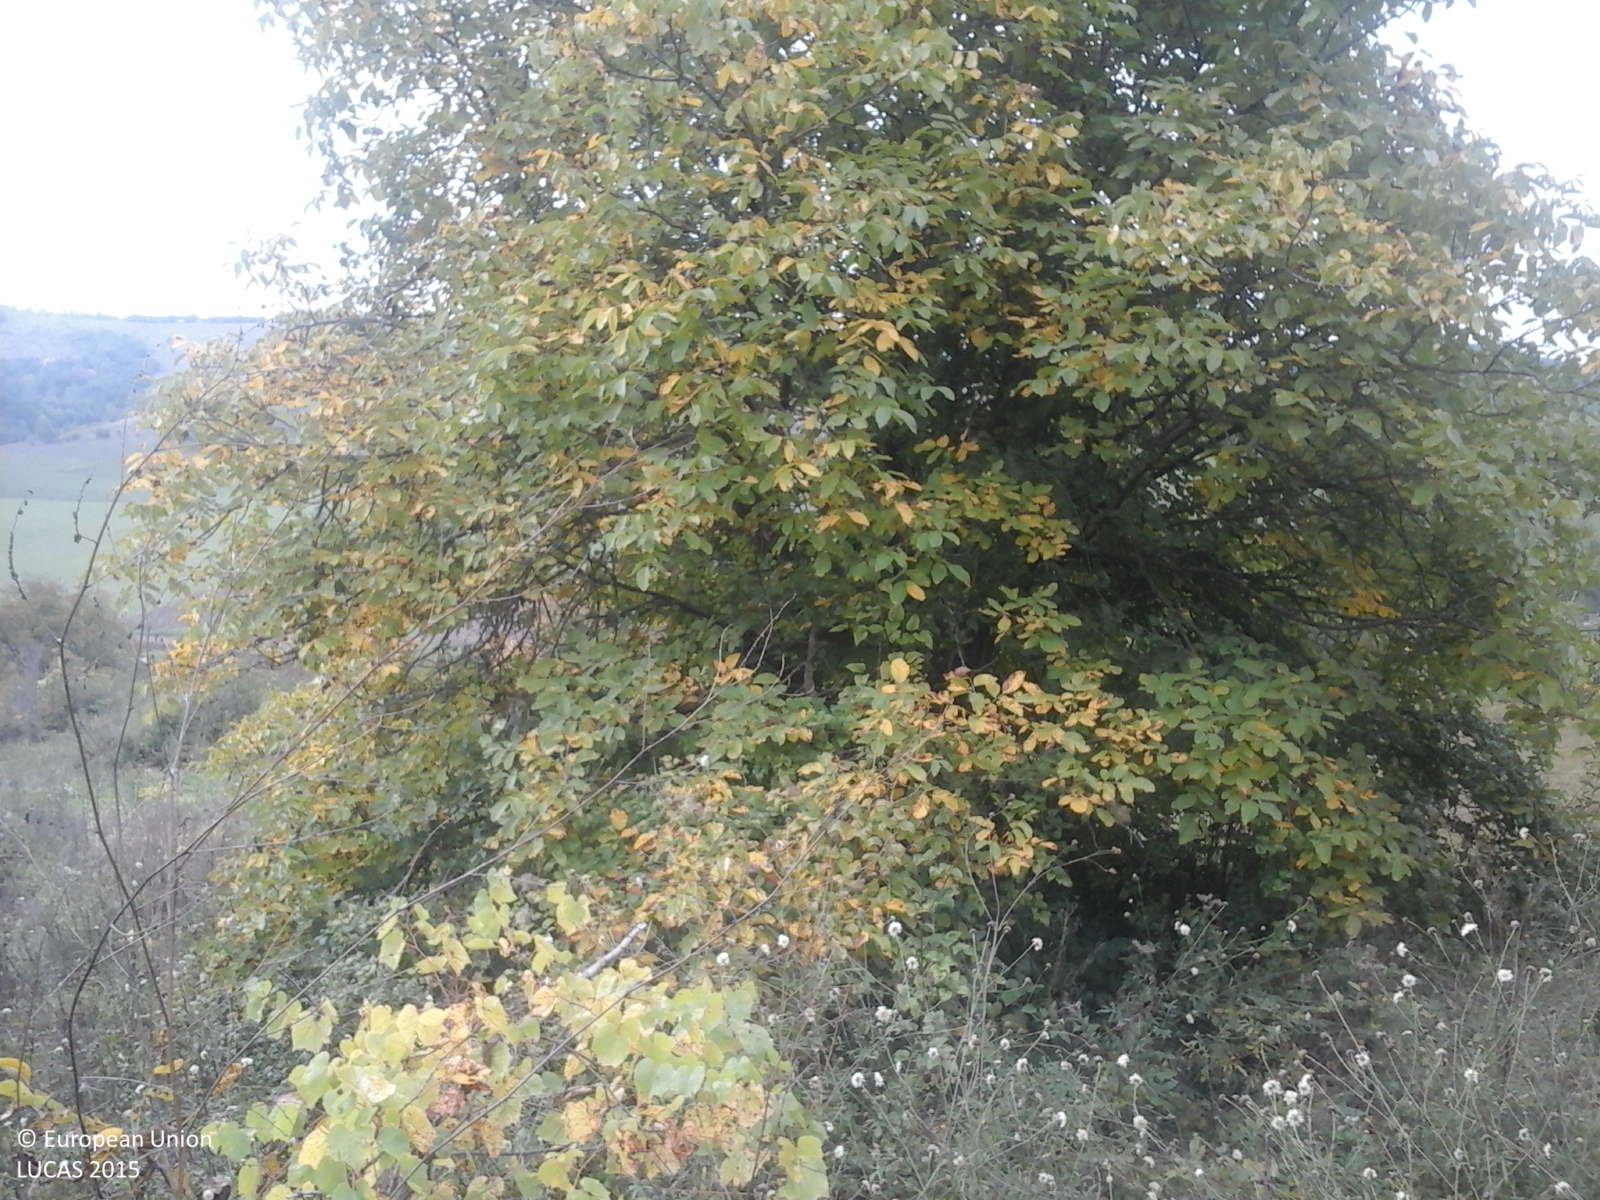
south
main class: Grassland
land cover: Spontaneously vegetated surfaces
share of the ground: > 75 %
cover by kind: herbaceous plants 100 %
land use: Fallow land
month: October
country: RO
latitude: 46.4892
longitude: 24.7746
